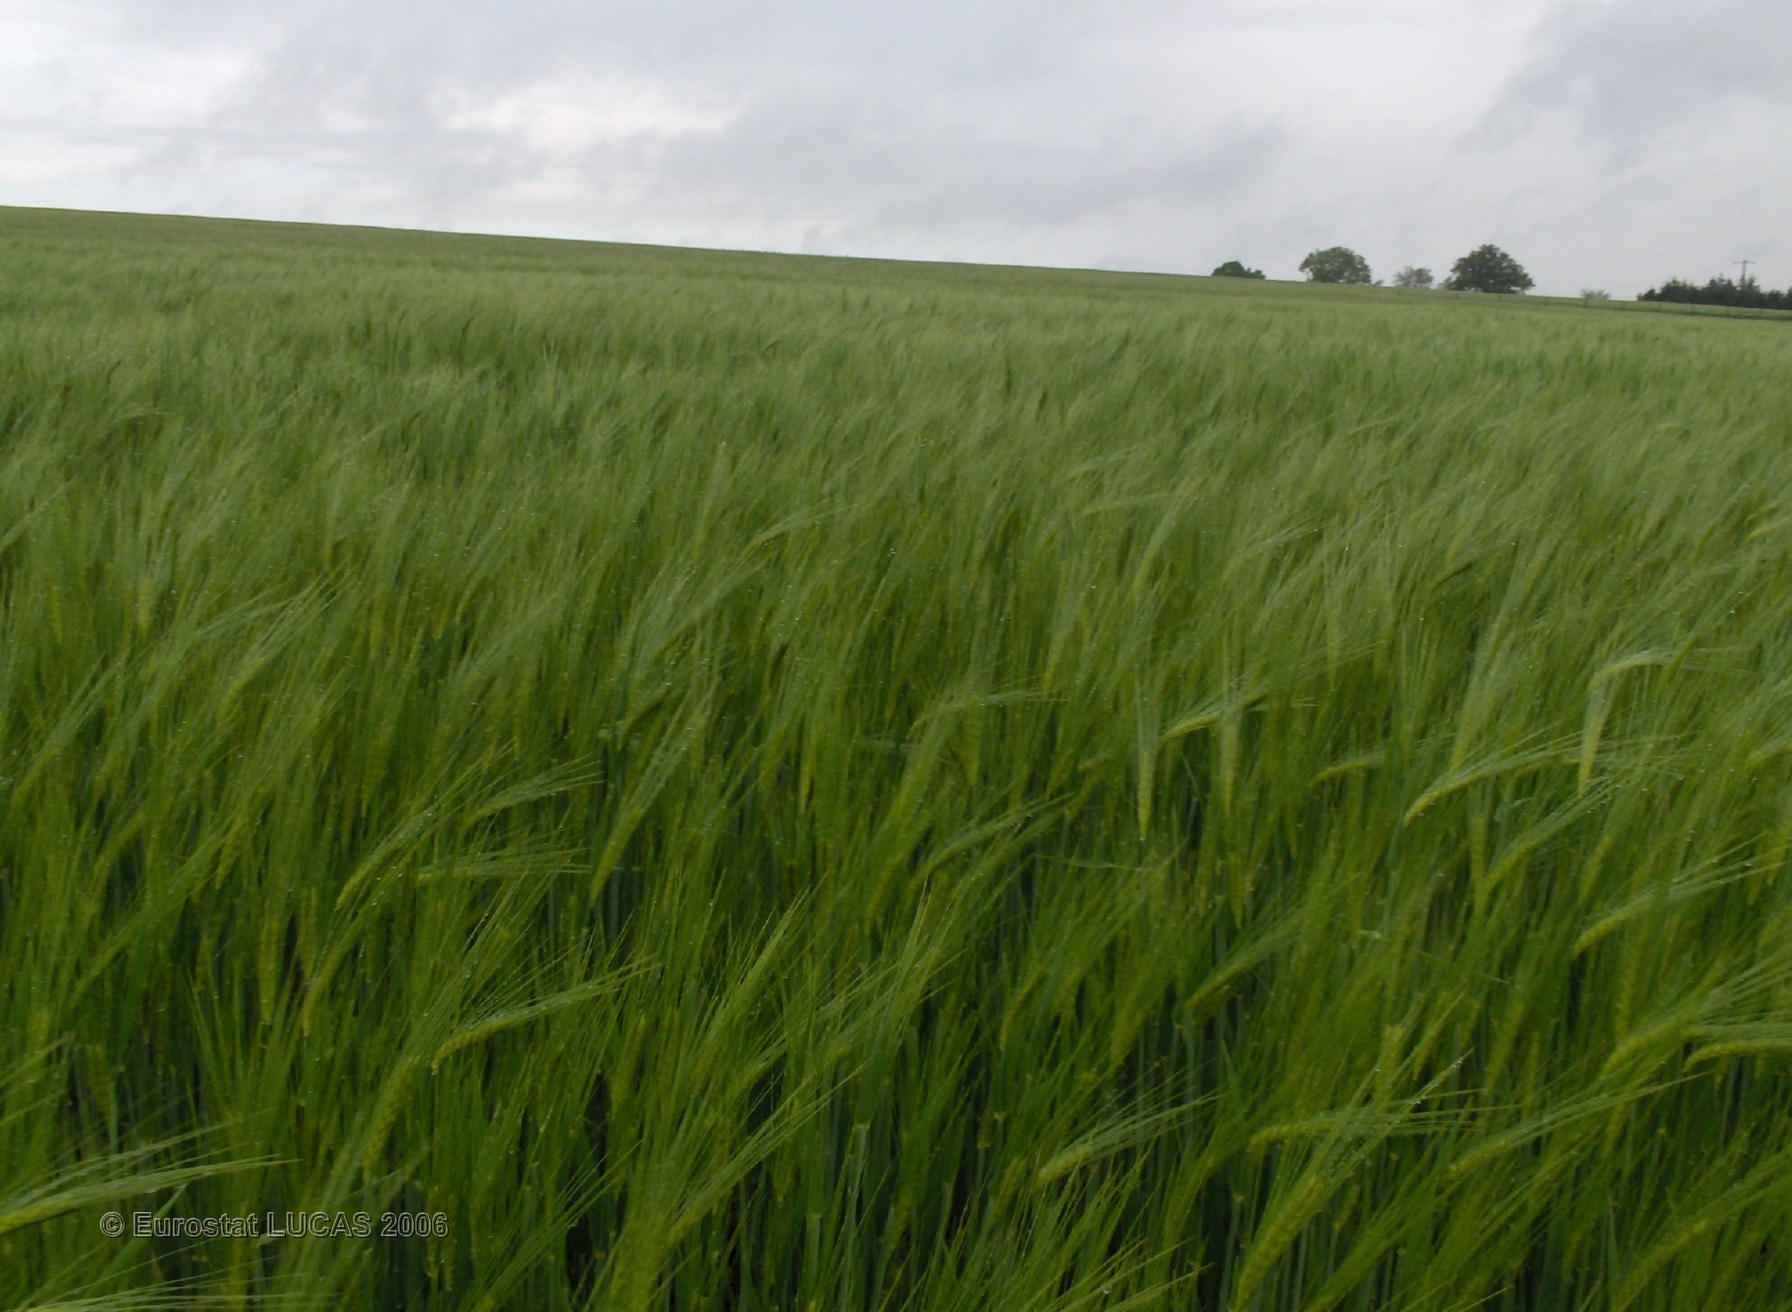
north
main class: Cropland
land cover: Barley
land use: Agriculture (excluding fallow land and kitchen gardens)
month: May
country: BE
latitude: 50.3739
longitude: 5.2593
